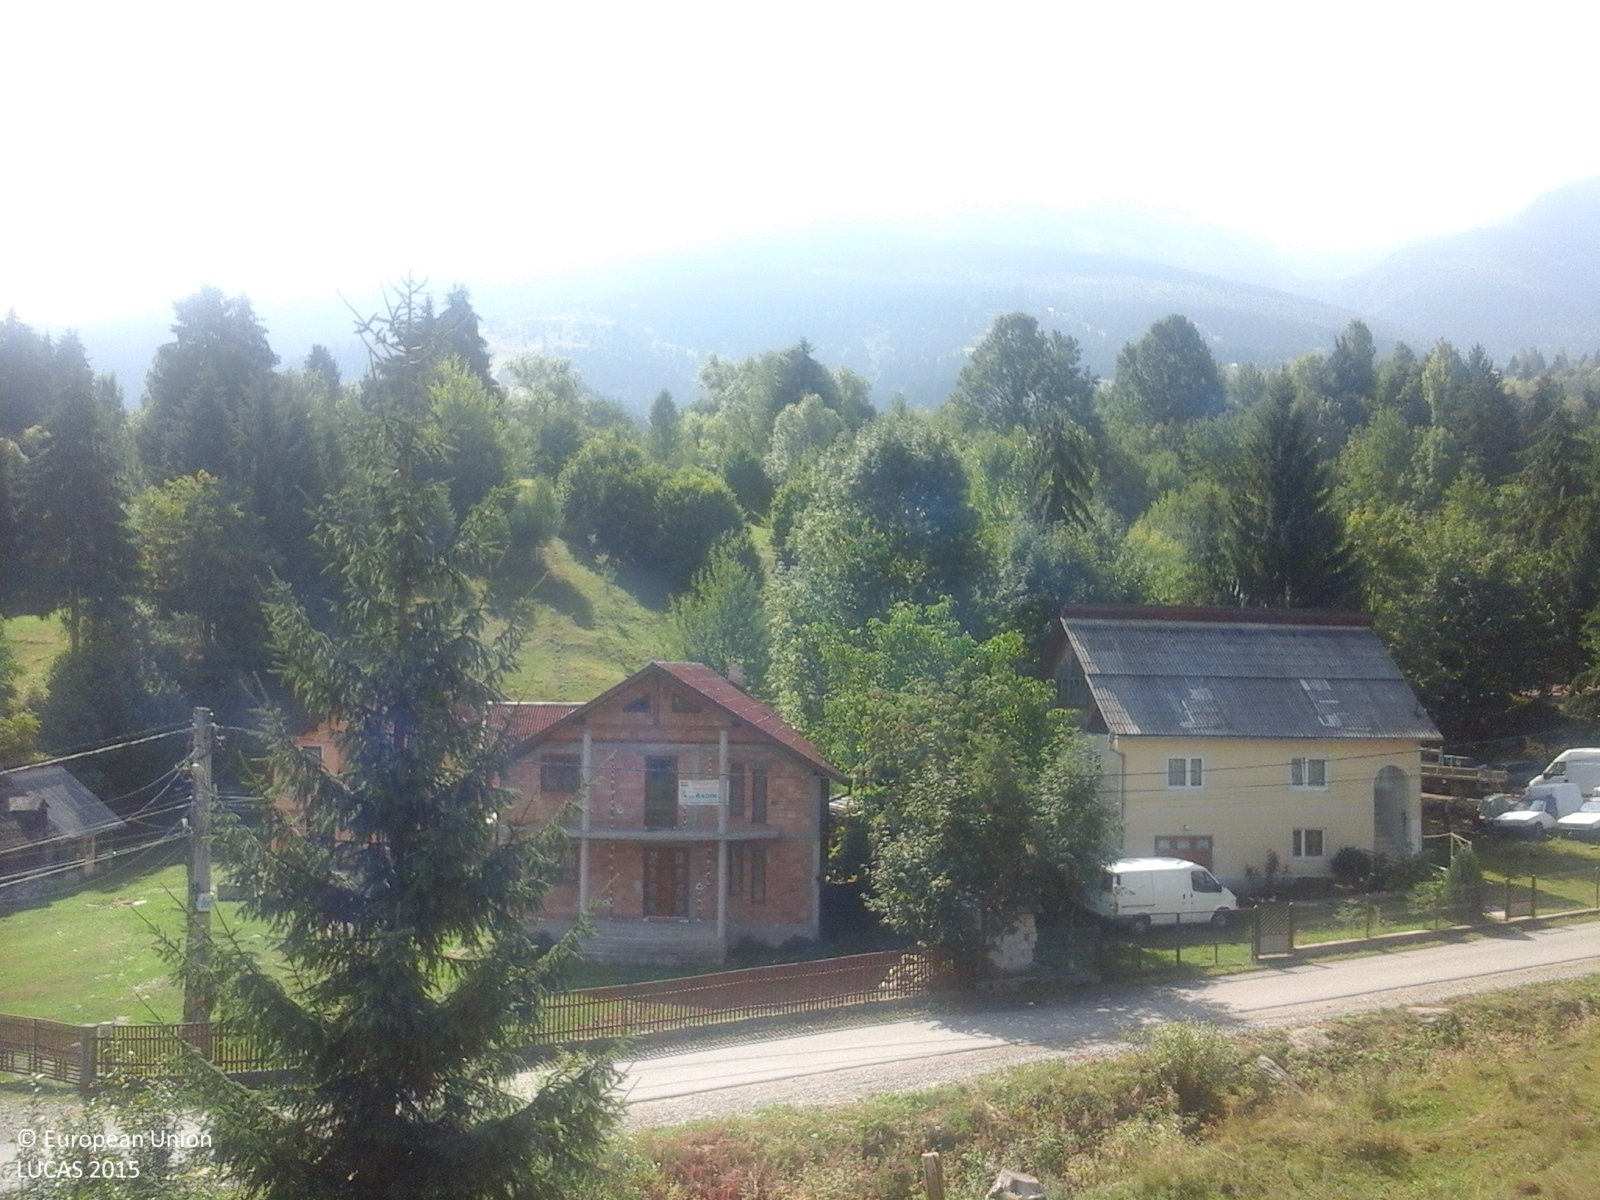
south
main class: Grassland
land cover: Grassland without tree/shrub cover
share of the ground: > 75 %
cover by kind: herbaceous plants 100 %
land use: Agriculture (excluding fallow land and kitchen gardens)
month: September
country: RO
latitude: 47.6373
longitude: 24.6723
